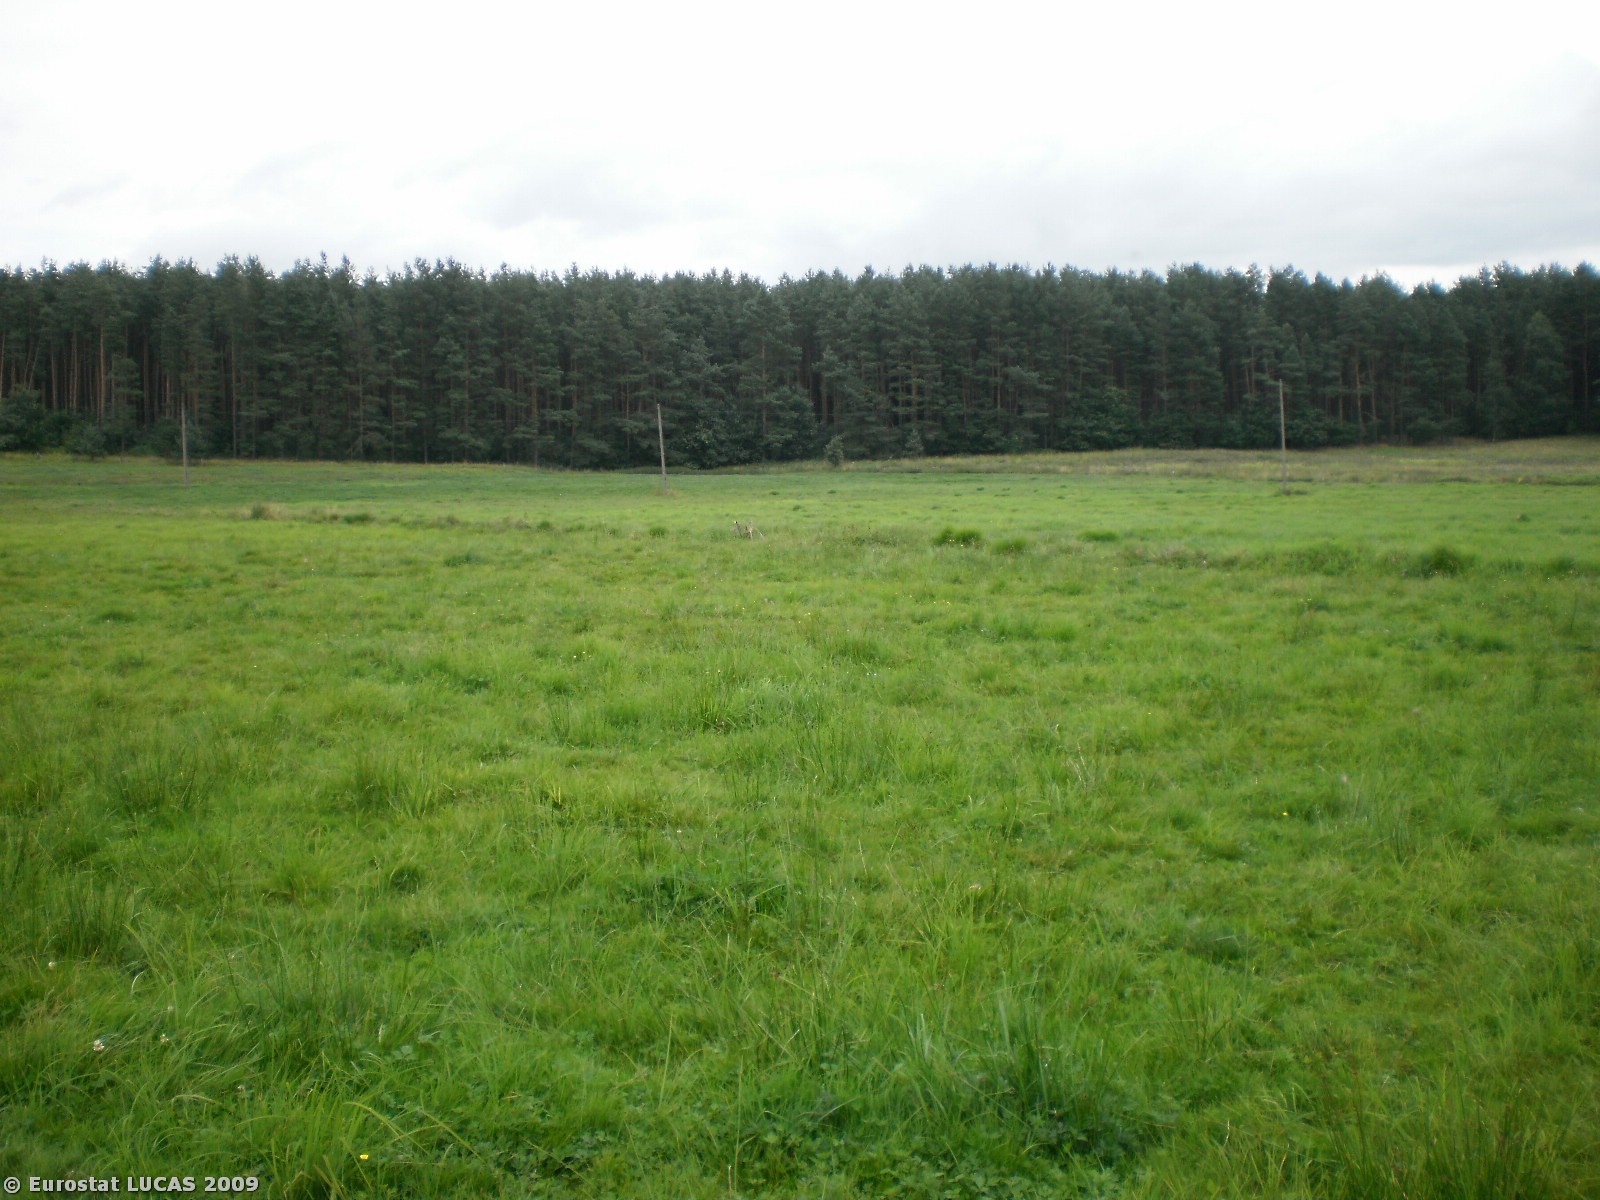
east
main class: Grassland
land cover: Grassland without tree/shrub cover
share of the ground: > 75 %
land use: Agriculture (excluding fallow land and kitchen gardens)
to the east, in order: Grassland without tree/shrub cover; Electric lines; Grassland without tree/shrub cover; Broadleaved woodland
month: August
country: PL
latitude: 54.0933
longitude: 20.6339
